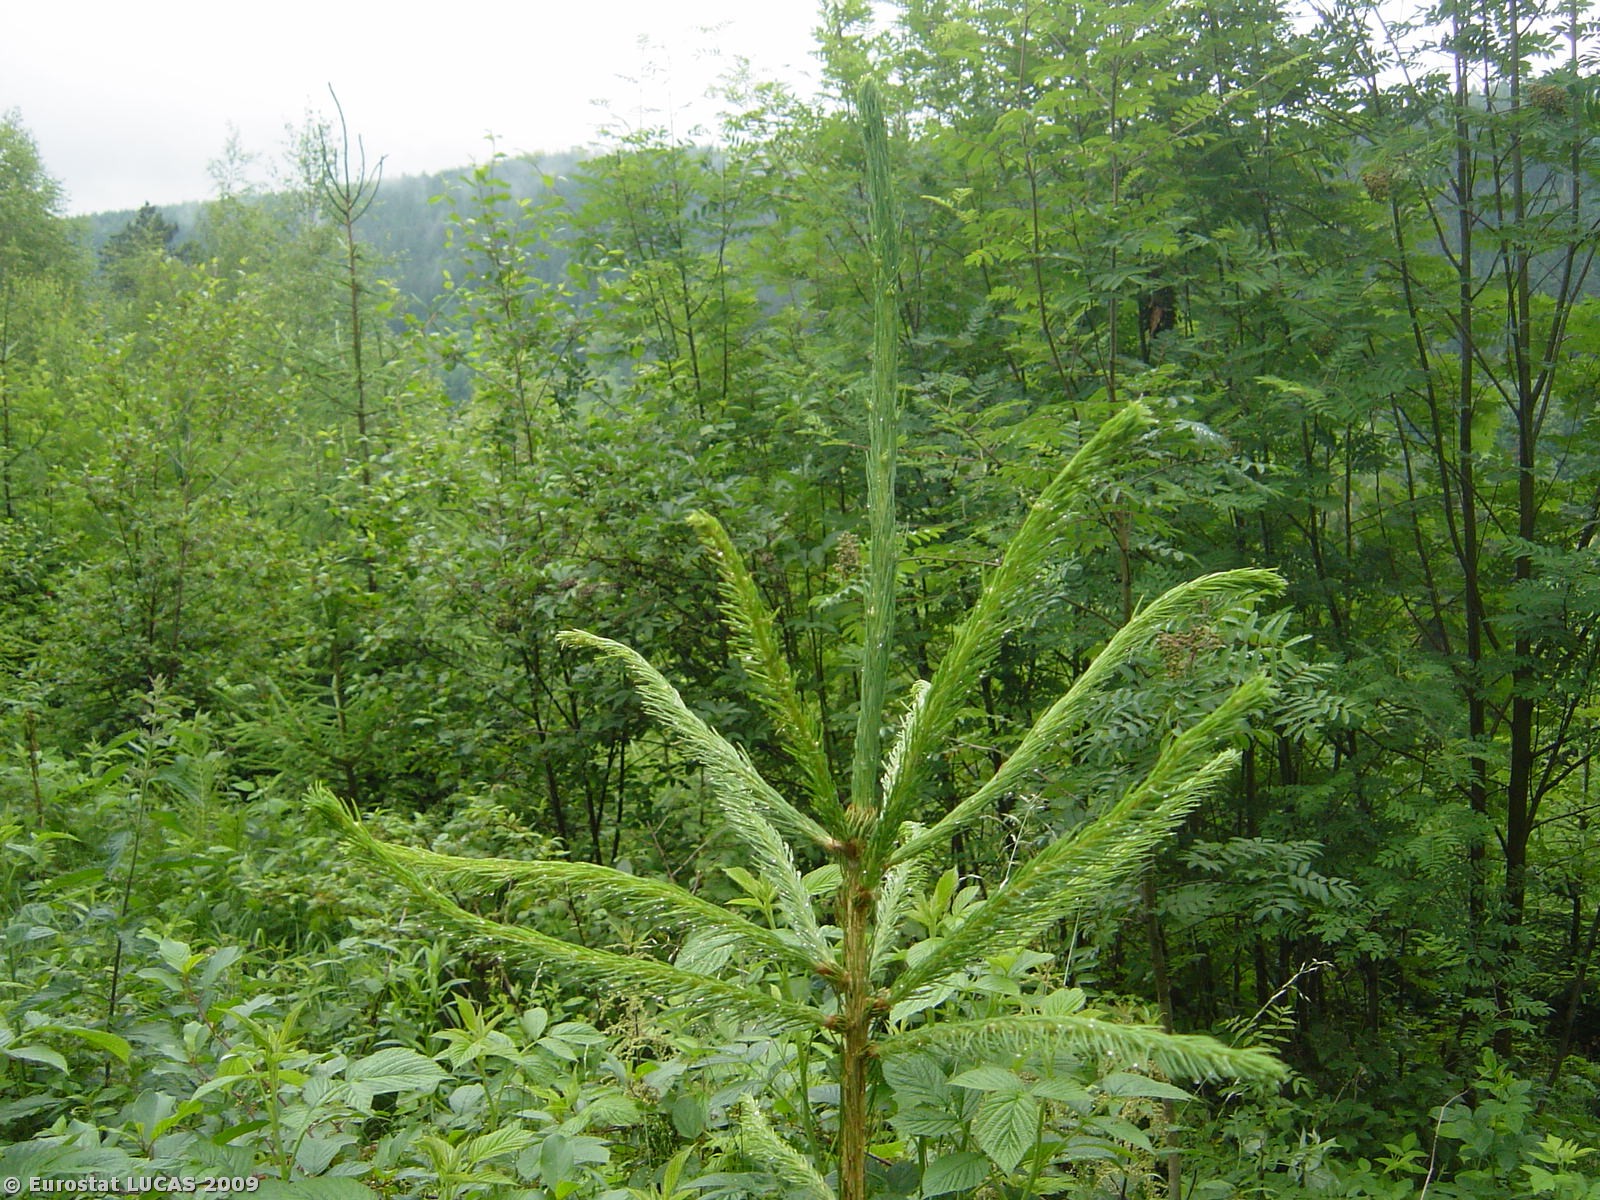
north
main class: Woodland
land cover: Mixed woodland
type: hemiboreal forest and nemoral coniferous forest and mixed broadleaved-coniferous forest
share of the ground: > 75 %
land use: Forestry
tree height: > 5 m
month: June
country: CZ
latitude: 49.6557
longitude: 16.5040
